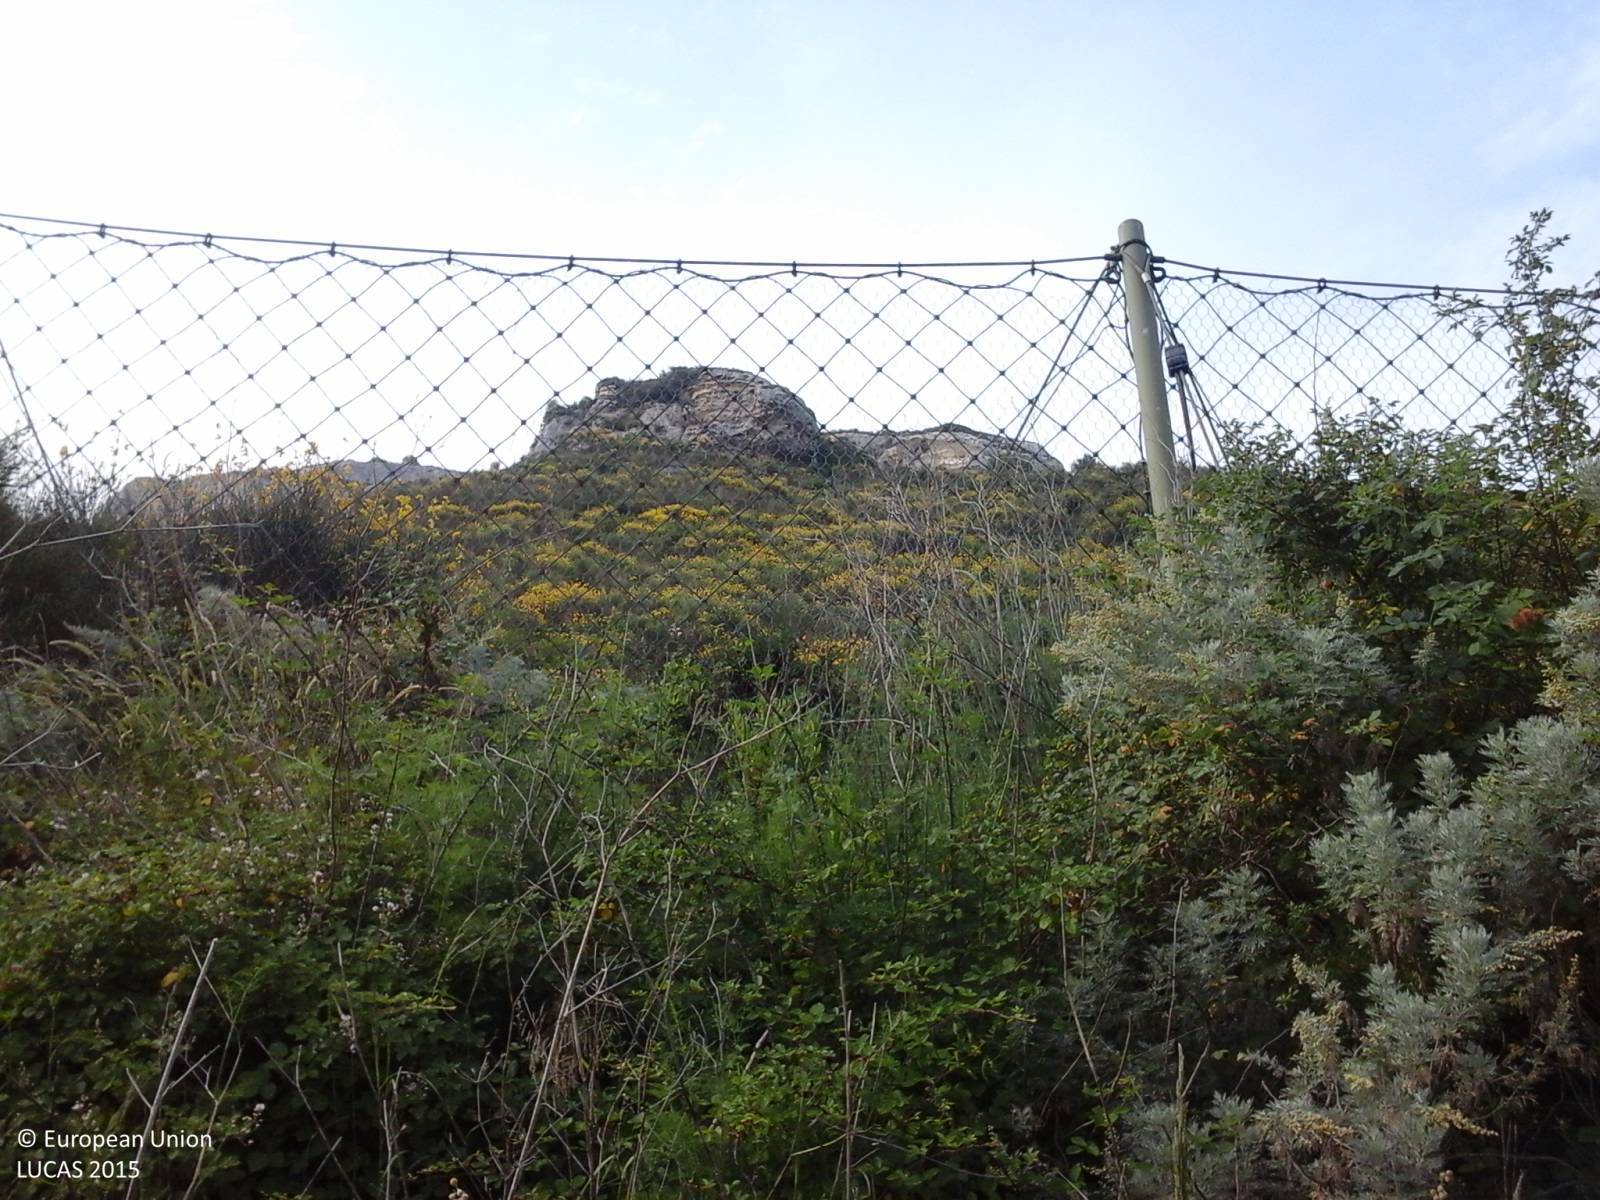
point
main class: Shrubland
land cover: Shrubland without tree cover
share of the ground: > 75 %
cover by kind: shrubs 85 %, herbaceous plants 15 %
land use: Semi-natural and natural areas not in use
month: June
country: IT
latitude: 40.6914
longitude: 8.5751
